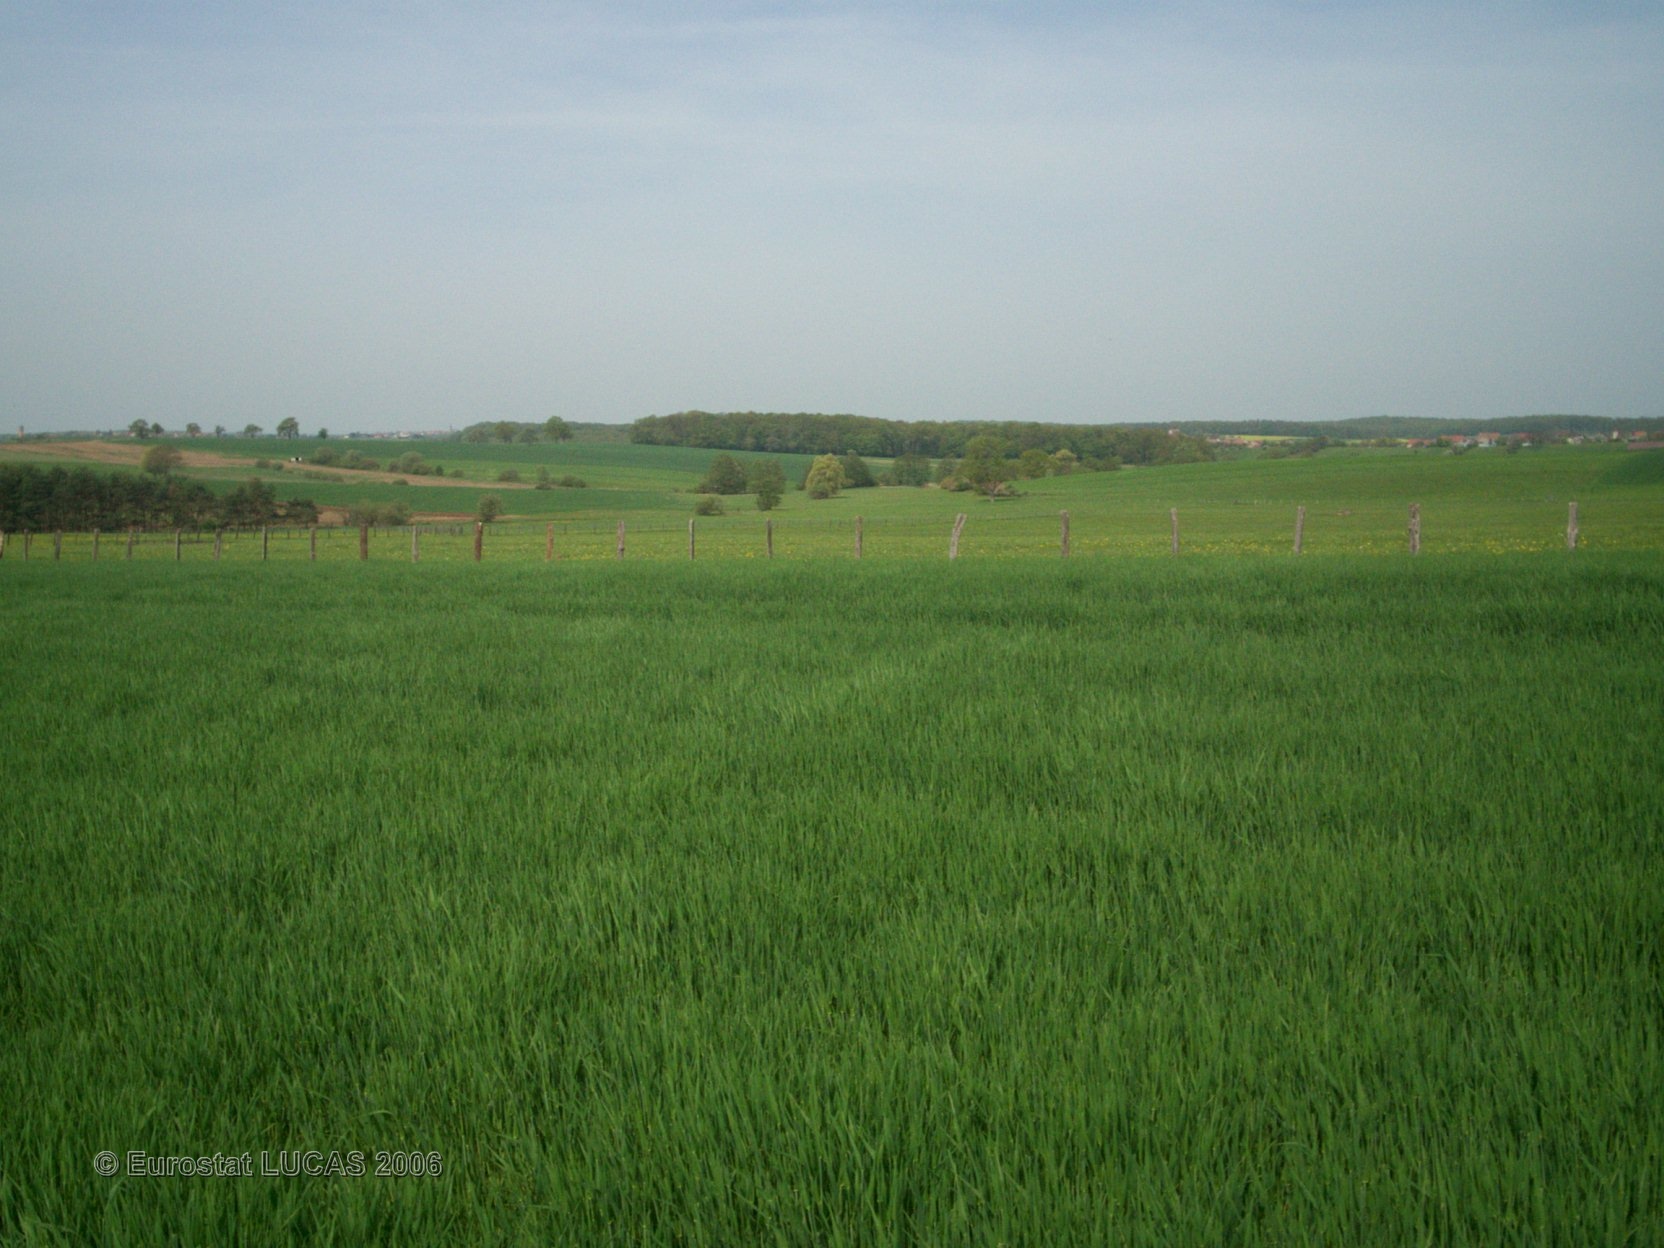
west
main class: Cropland
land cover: Barley
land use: Agriculture (excluding fallow land and kitchen gardens)
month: May
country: FR
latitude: 48.9392
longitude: 7.0106
